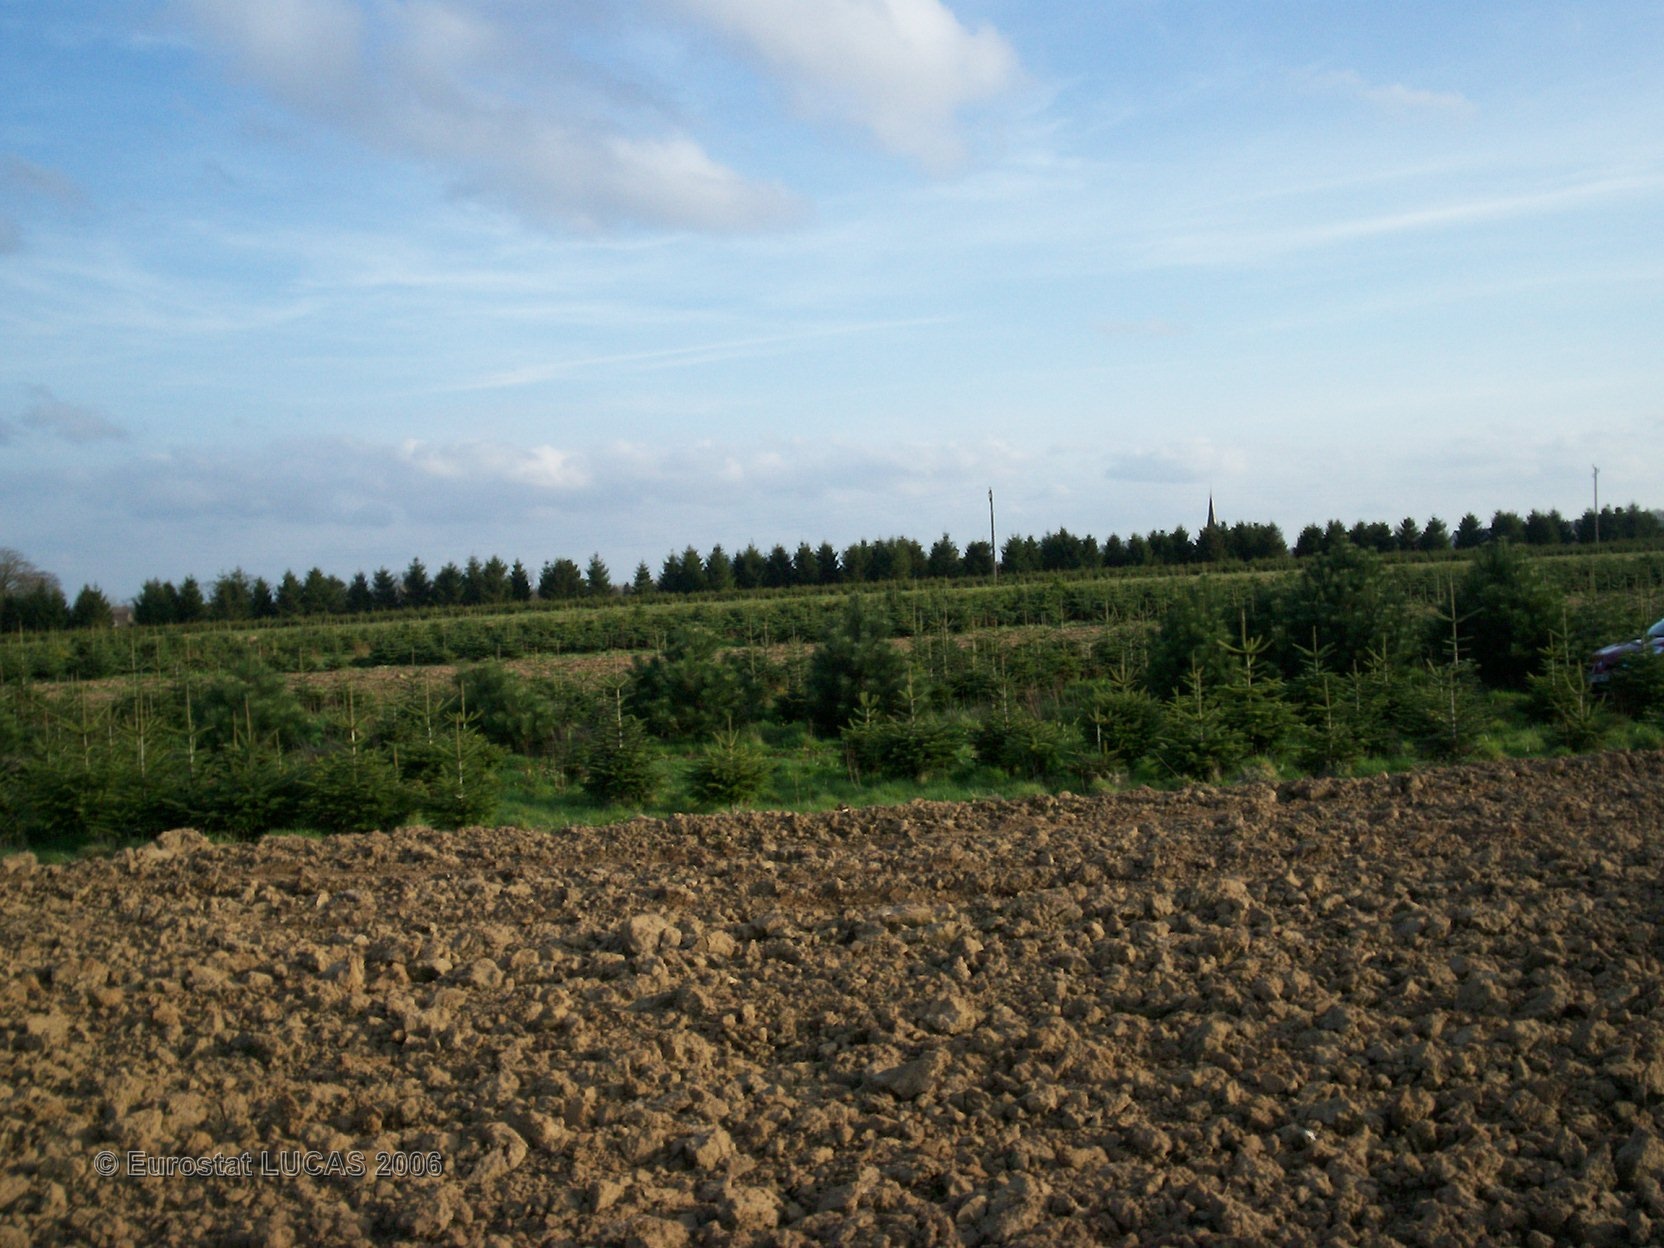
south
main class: Cropland
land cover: Maize
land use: Agriculture (excluding fallow land and kitchen gardens)
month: April
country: FR
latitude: 49.6749
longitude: 0.8999
